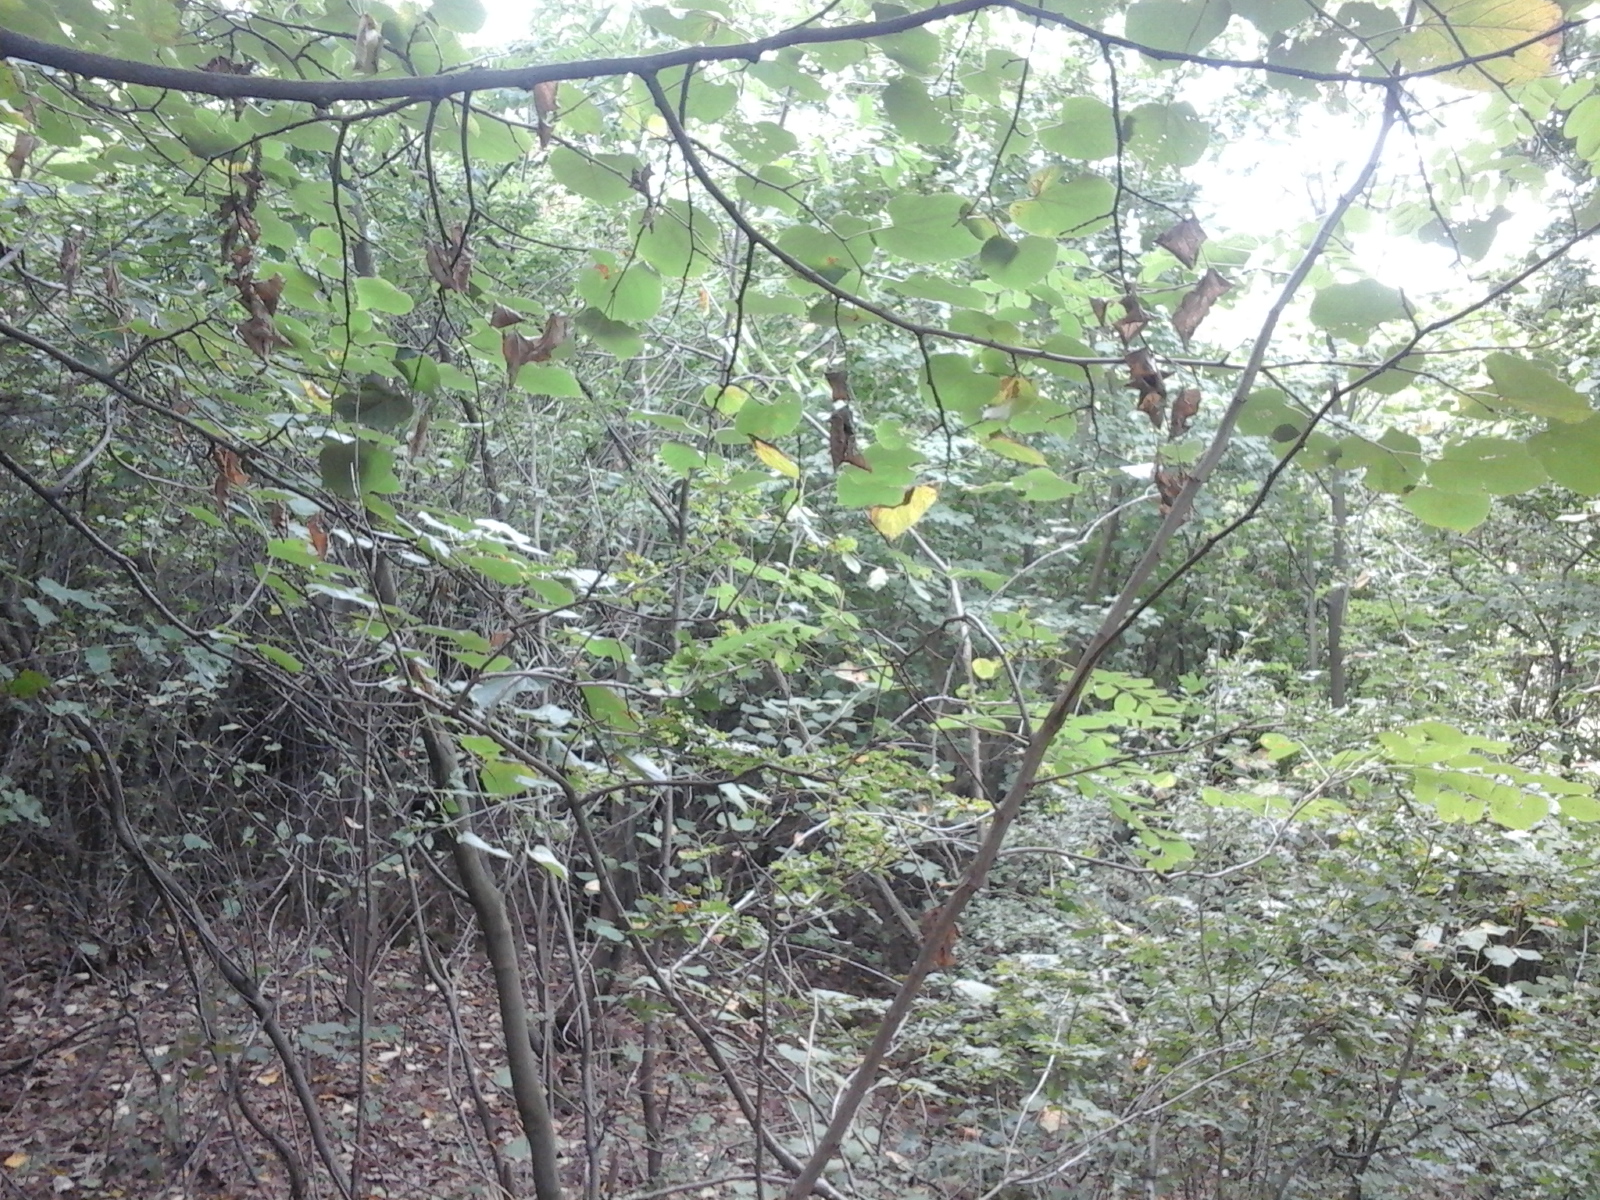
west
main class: Woodland
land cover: Broadleaved woodland
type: beech forest
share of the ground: > 75 %
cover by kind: broadleaved forest trees 100 %
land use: Forestry
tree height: > 5 m
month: August
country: RO
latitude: 46.2758
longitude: 21.6530
